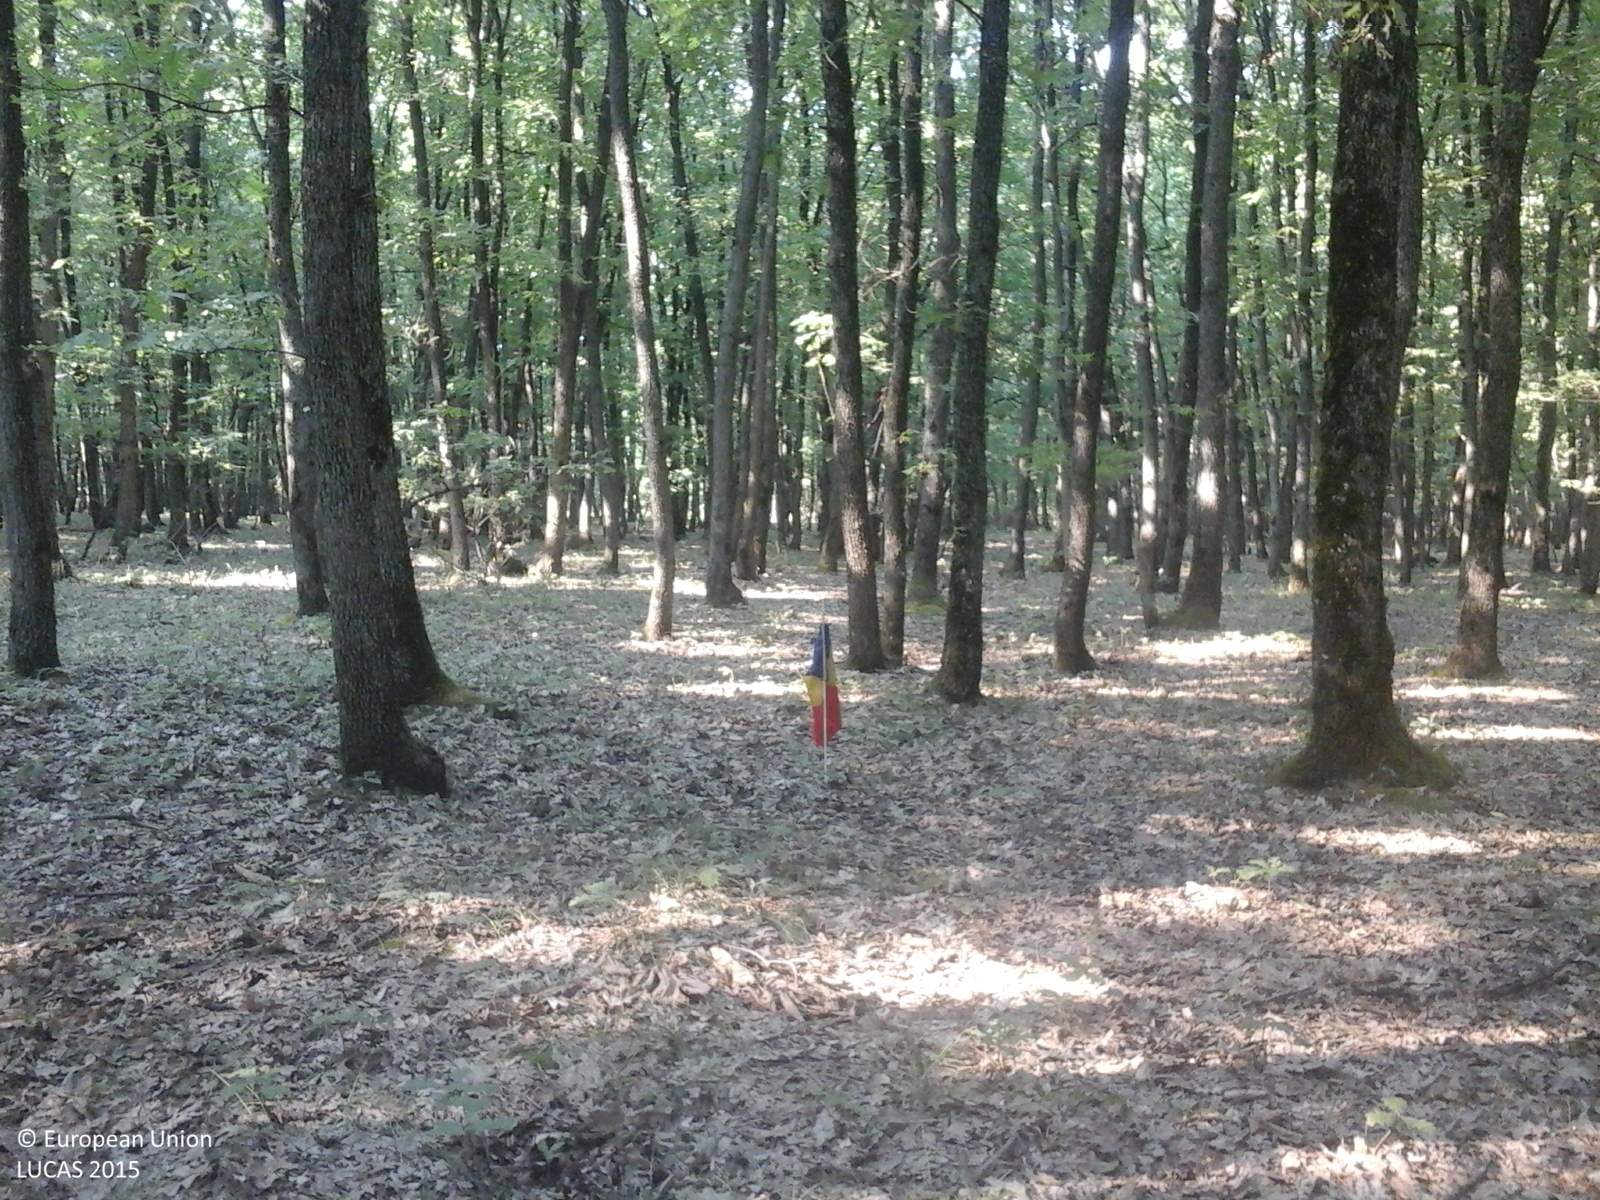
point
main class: Woodland
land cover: Broadleaved woodland
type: acidophilous oak and oak-birch forest
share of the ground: > 75 %
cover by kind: broadleaved forest trees 100 %
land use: Forestry
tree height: > 5 m
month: July
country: RO
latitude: 44.6034
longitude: 24.5238
